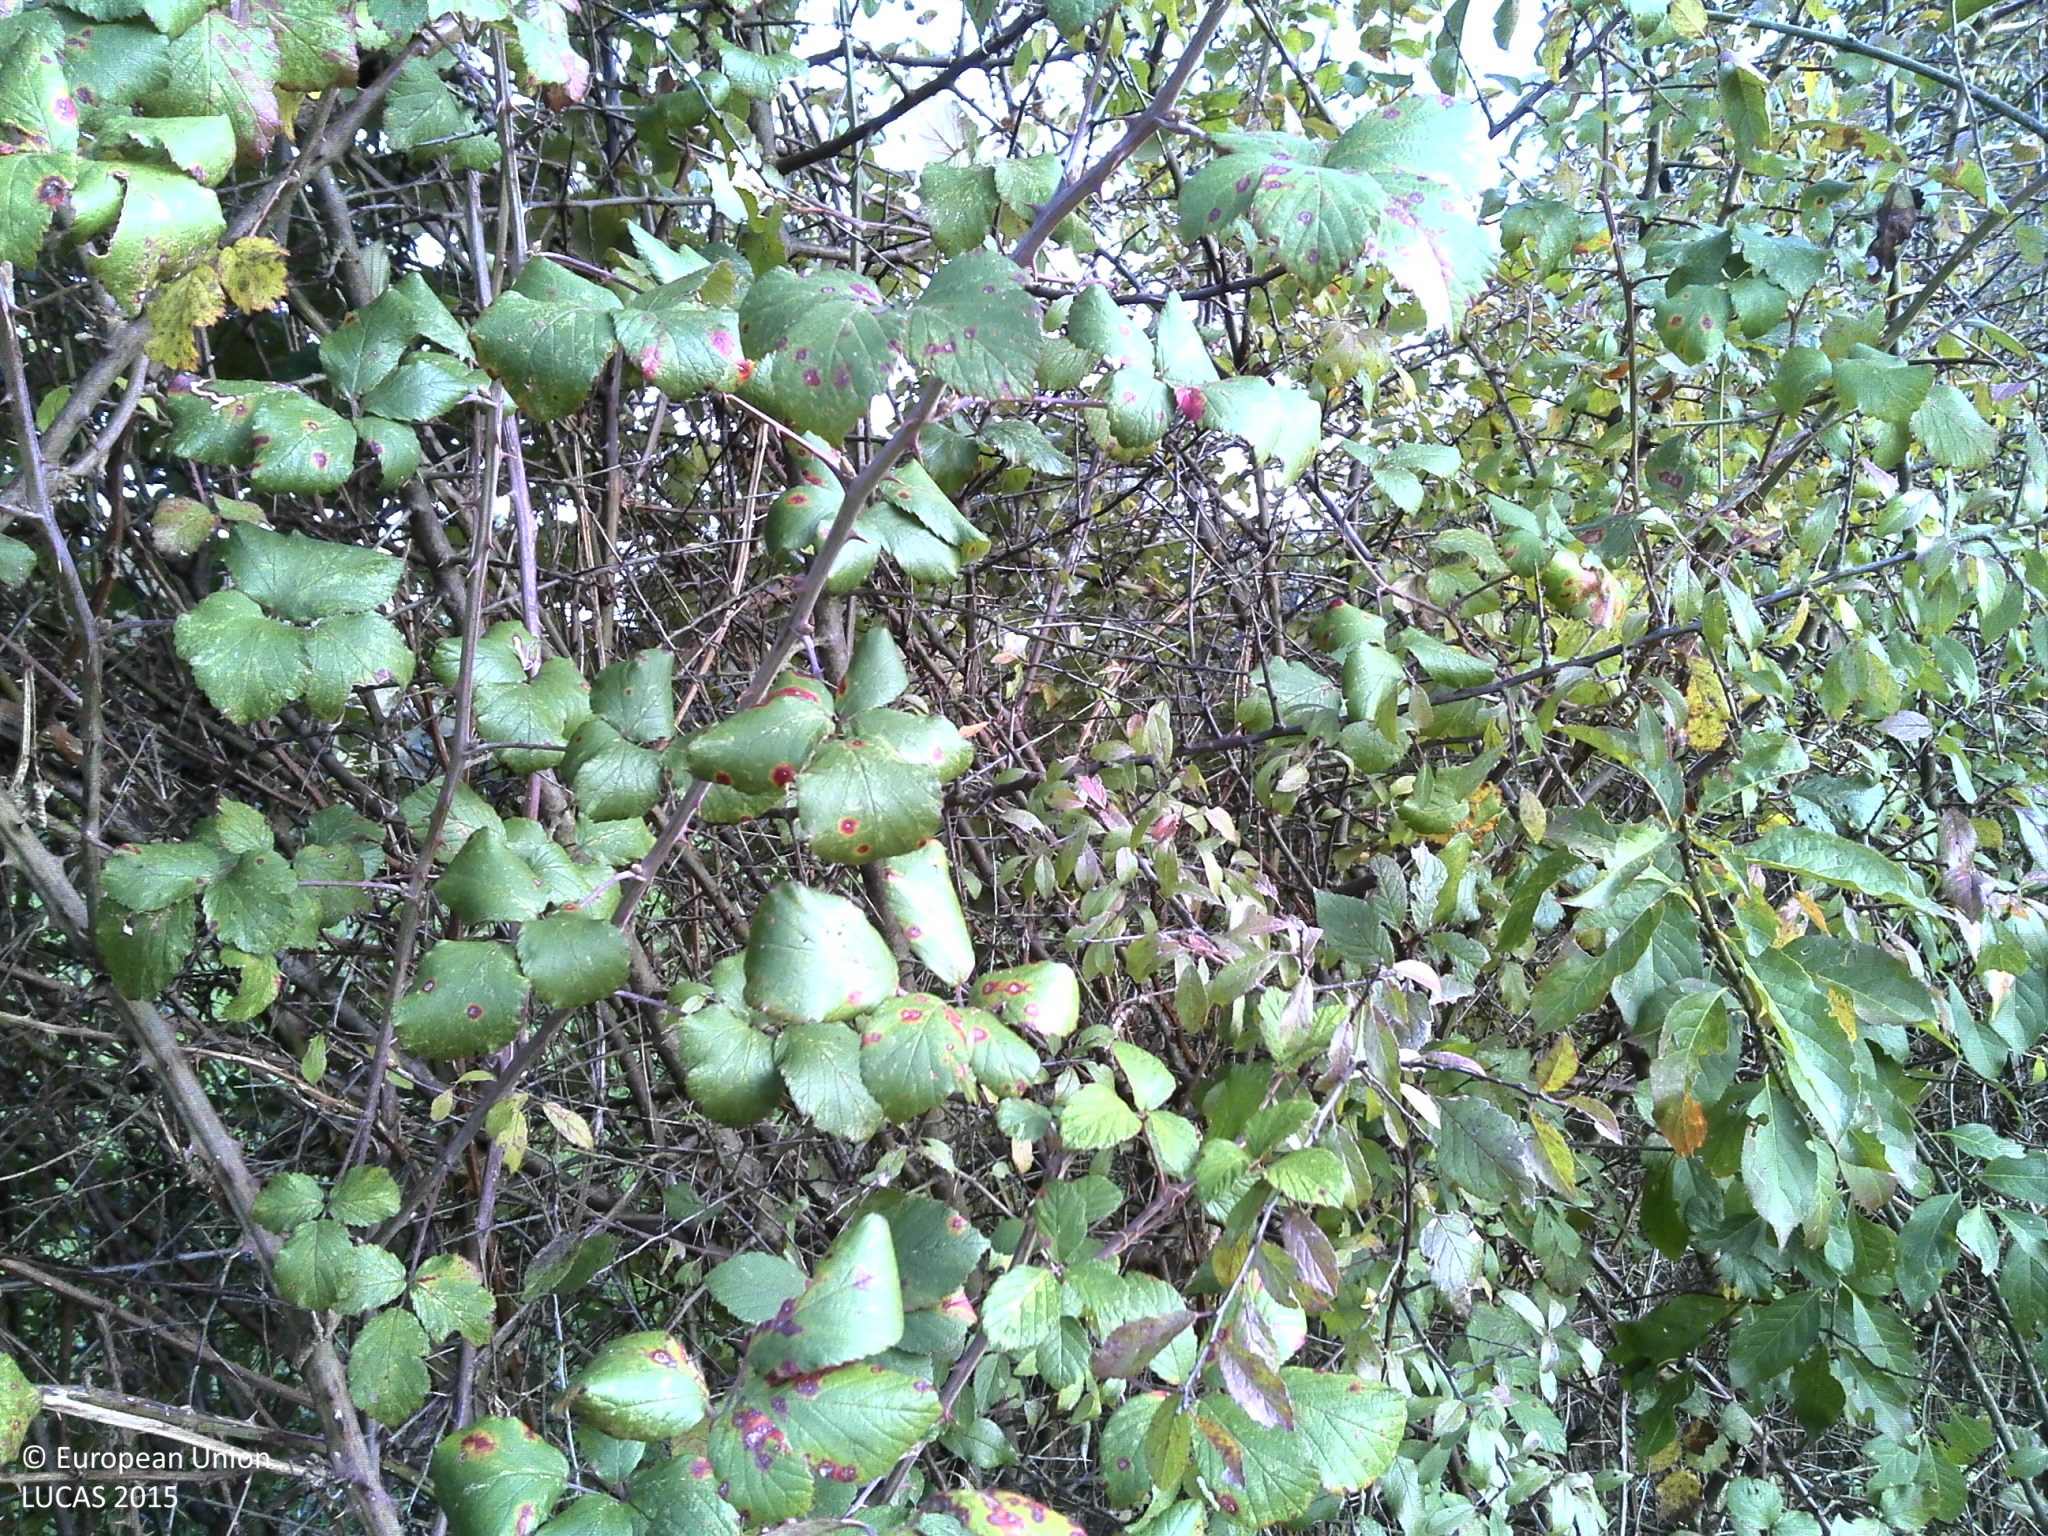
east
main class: Grassland
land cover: Grassland without tree/shrub cover
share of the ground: > 75 %
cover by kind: herbaceous plants 100 %
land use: Agriculture (excluding fallow land and kitchen gardens)
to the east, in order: Abandoned hedges; Fences; Grassland without tree/shrub cover; Broadleaved woodland; Grassland without tree/shrub cover; Fences; Lucerne; Grass margins; Paved roads, cycling and walking lanes; Grass margins; Broadleaved woodland
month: October
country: FR
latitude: 46.1433
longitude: 5.3816
